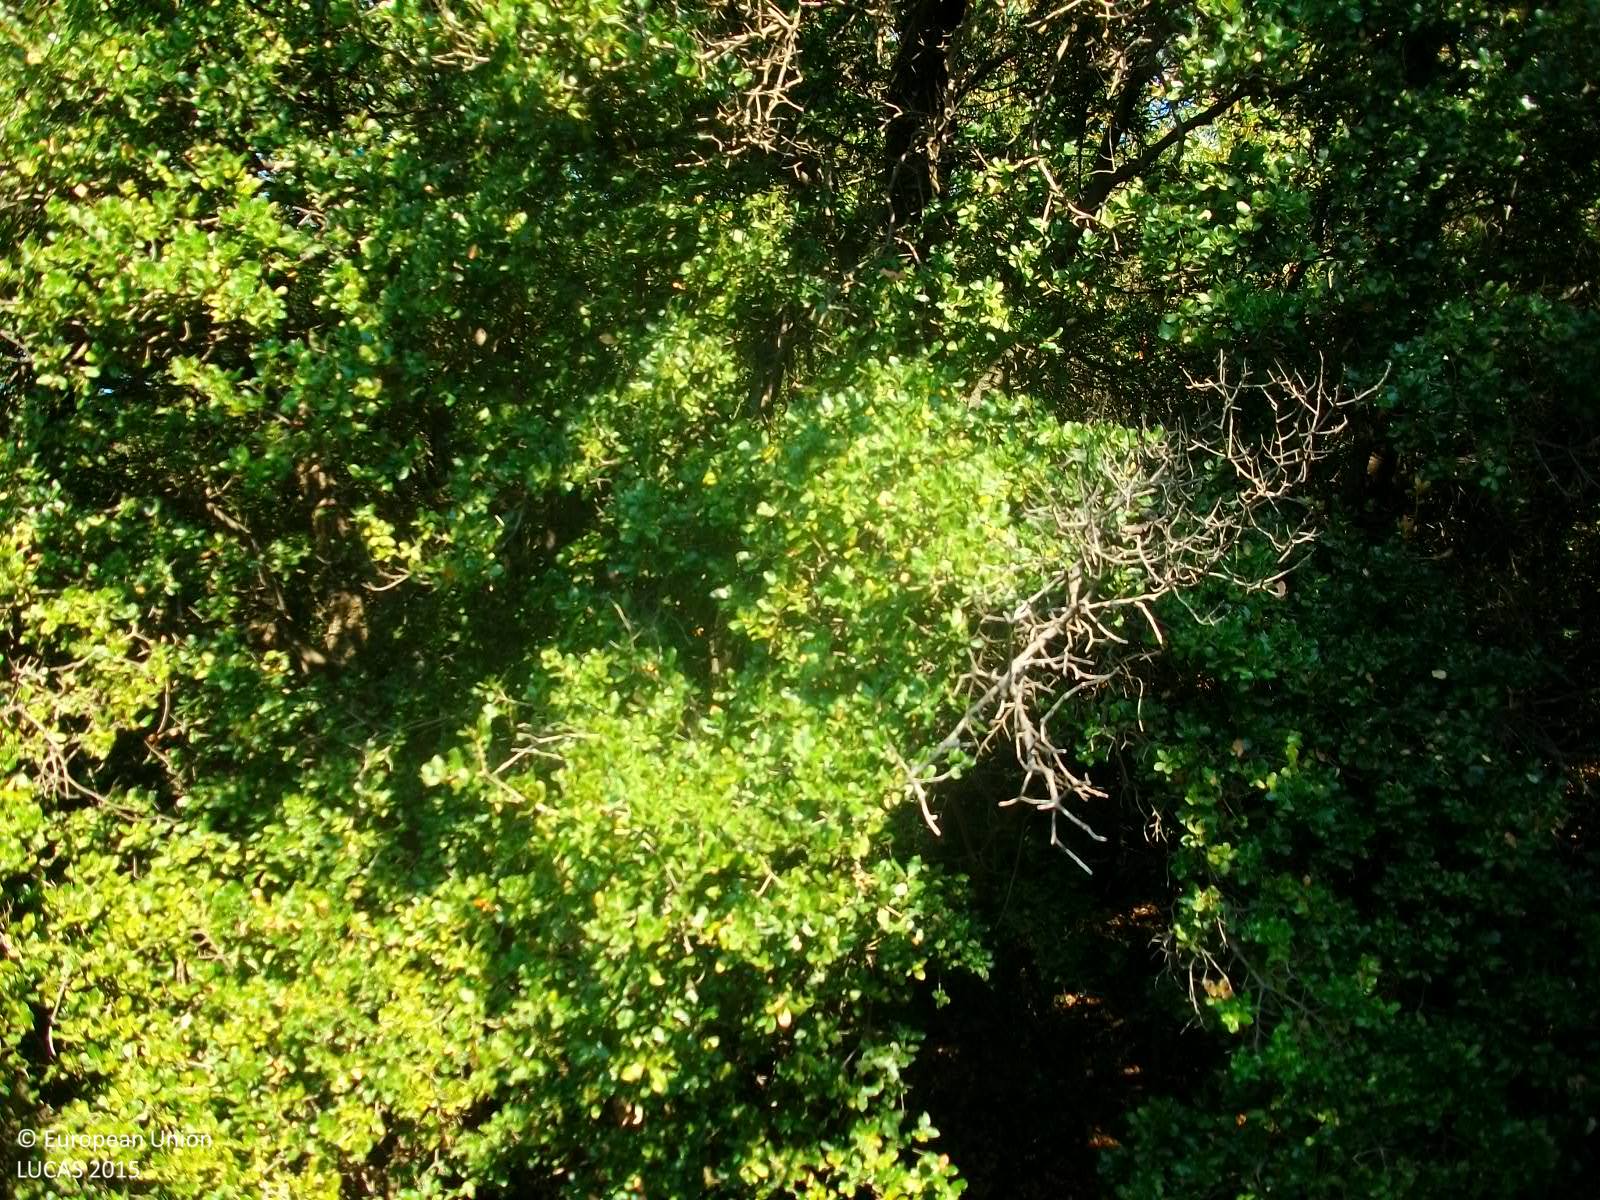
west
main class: Shrubland
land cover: Shrubland with sparse tree cover
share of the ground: > 75 %
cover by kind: shrubs 95 %, broadleaved forest trees 5 %
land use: Semi-natural and natural areas not in use
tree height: > 5 m
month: July
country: GR
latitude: 37.4308
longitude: 21.9486
